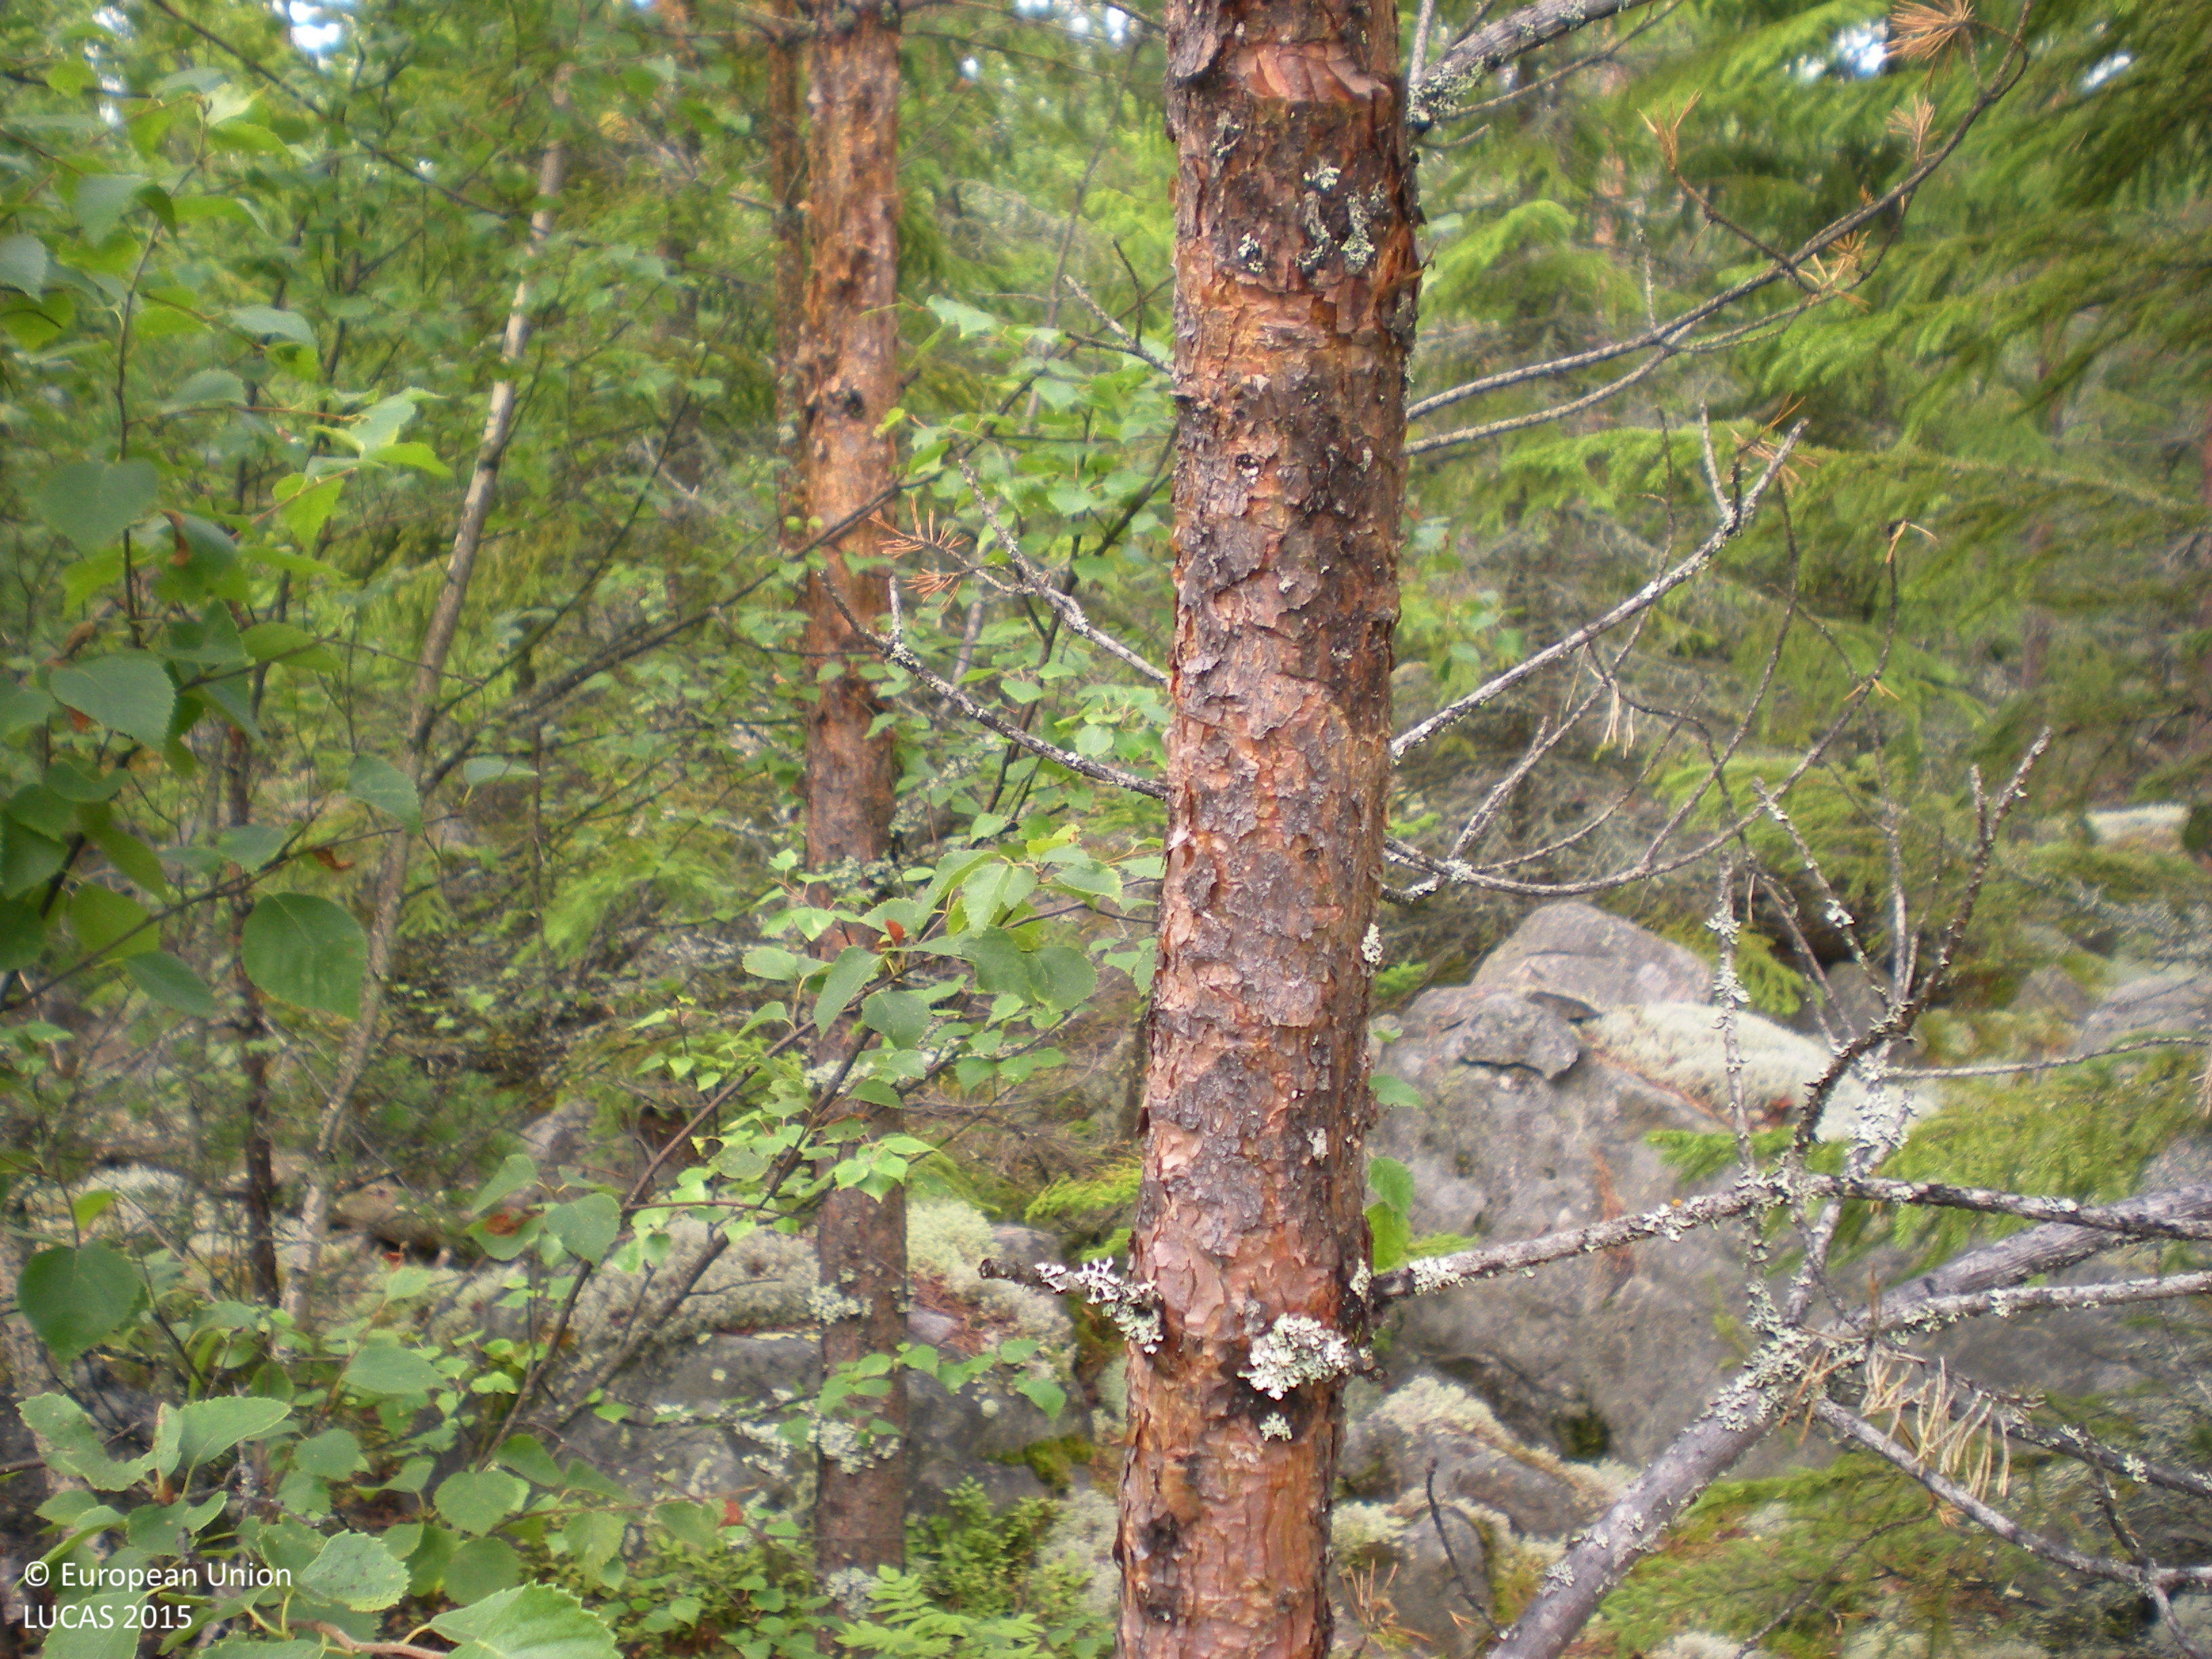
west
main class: Woodland
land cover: Pine dominated coniferous woodland
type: boreal forest
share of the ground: 50 - 75 %
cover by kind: coniferous forest trees 60 %, consolidated bare surface 15 %, lichens and mosses 10 %, broadleaved forest trees 5 %, shrubs 5 %, herbaceous plants 5 %
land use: Forestry
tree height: < 5 m
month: August
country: SE
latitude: 60.7708
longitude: 16.9093
